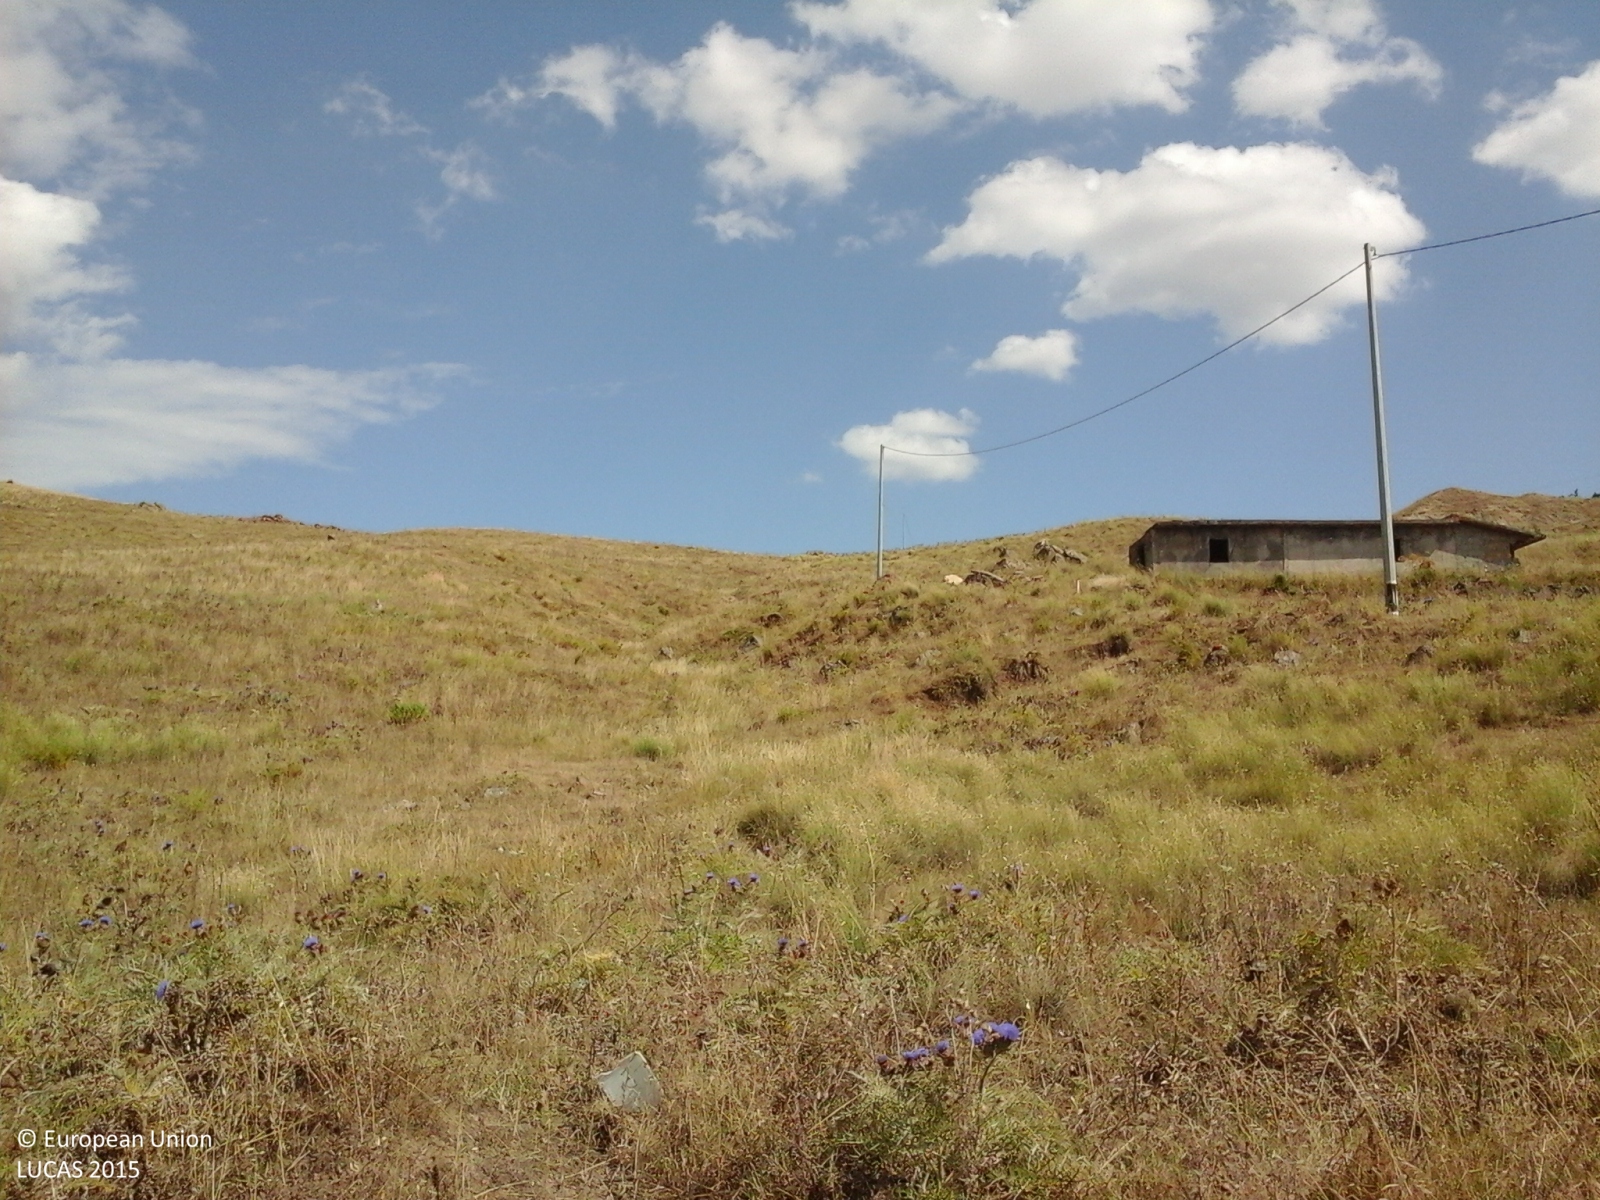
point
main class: Grassland
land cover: Grassland without tree/shrub cover
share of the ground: > 75 %
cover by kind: herbaceous plants 100 %
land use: Agriculture (excluding fallow land and kitchen gardens)
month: June
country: IT
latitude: 37.5321
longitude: 14.8649
